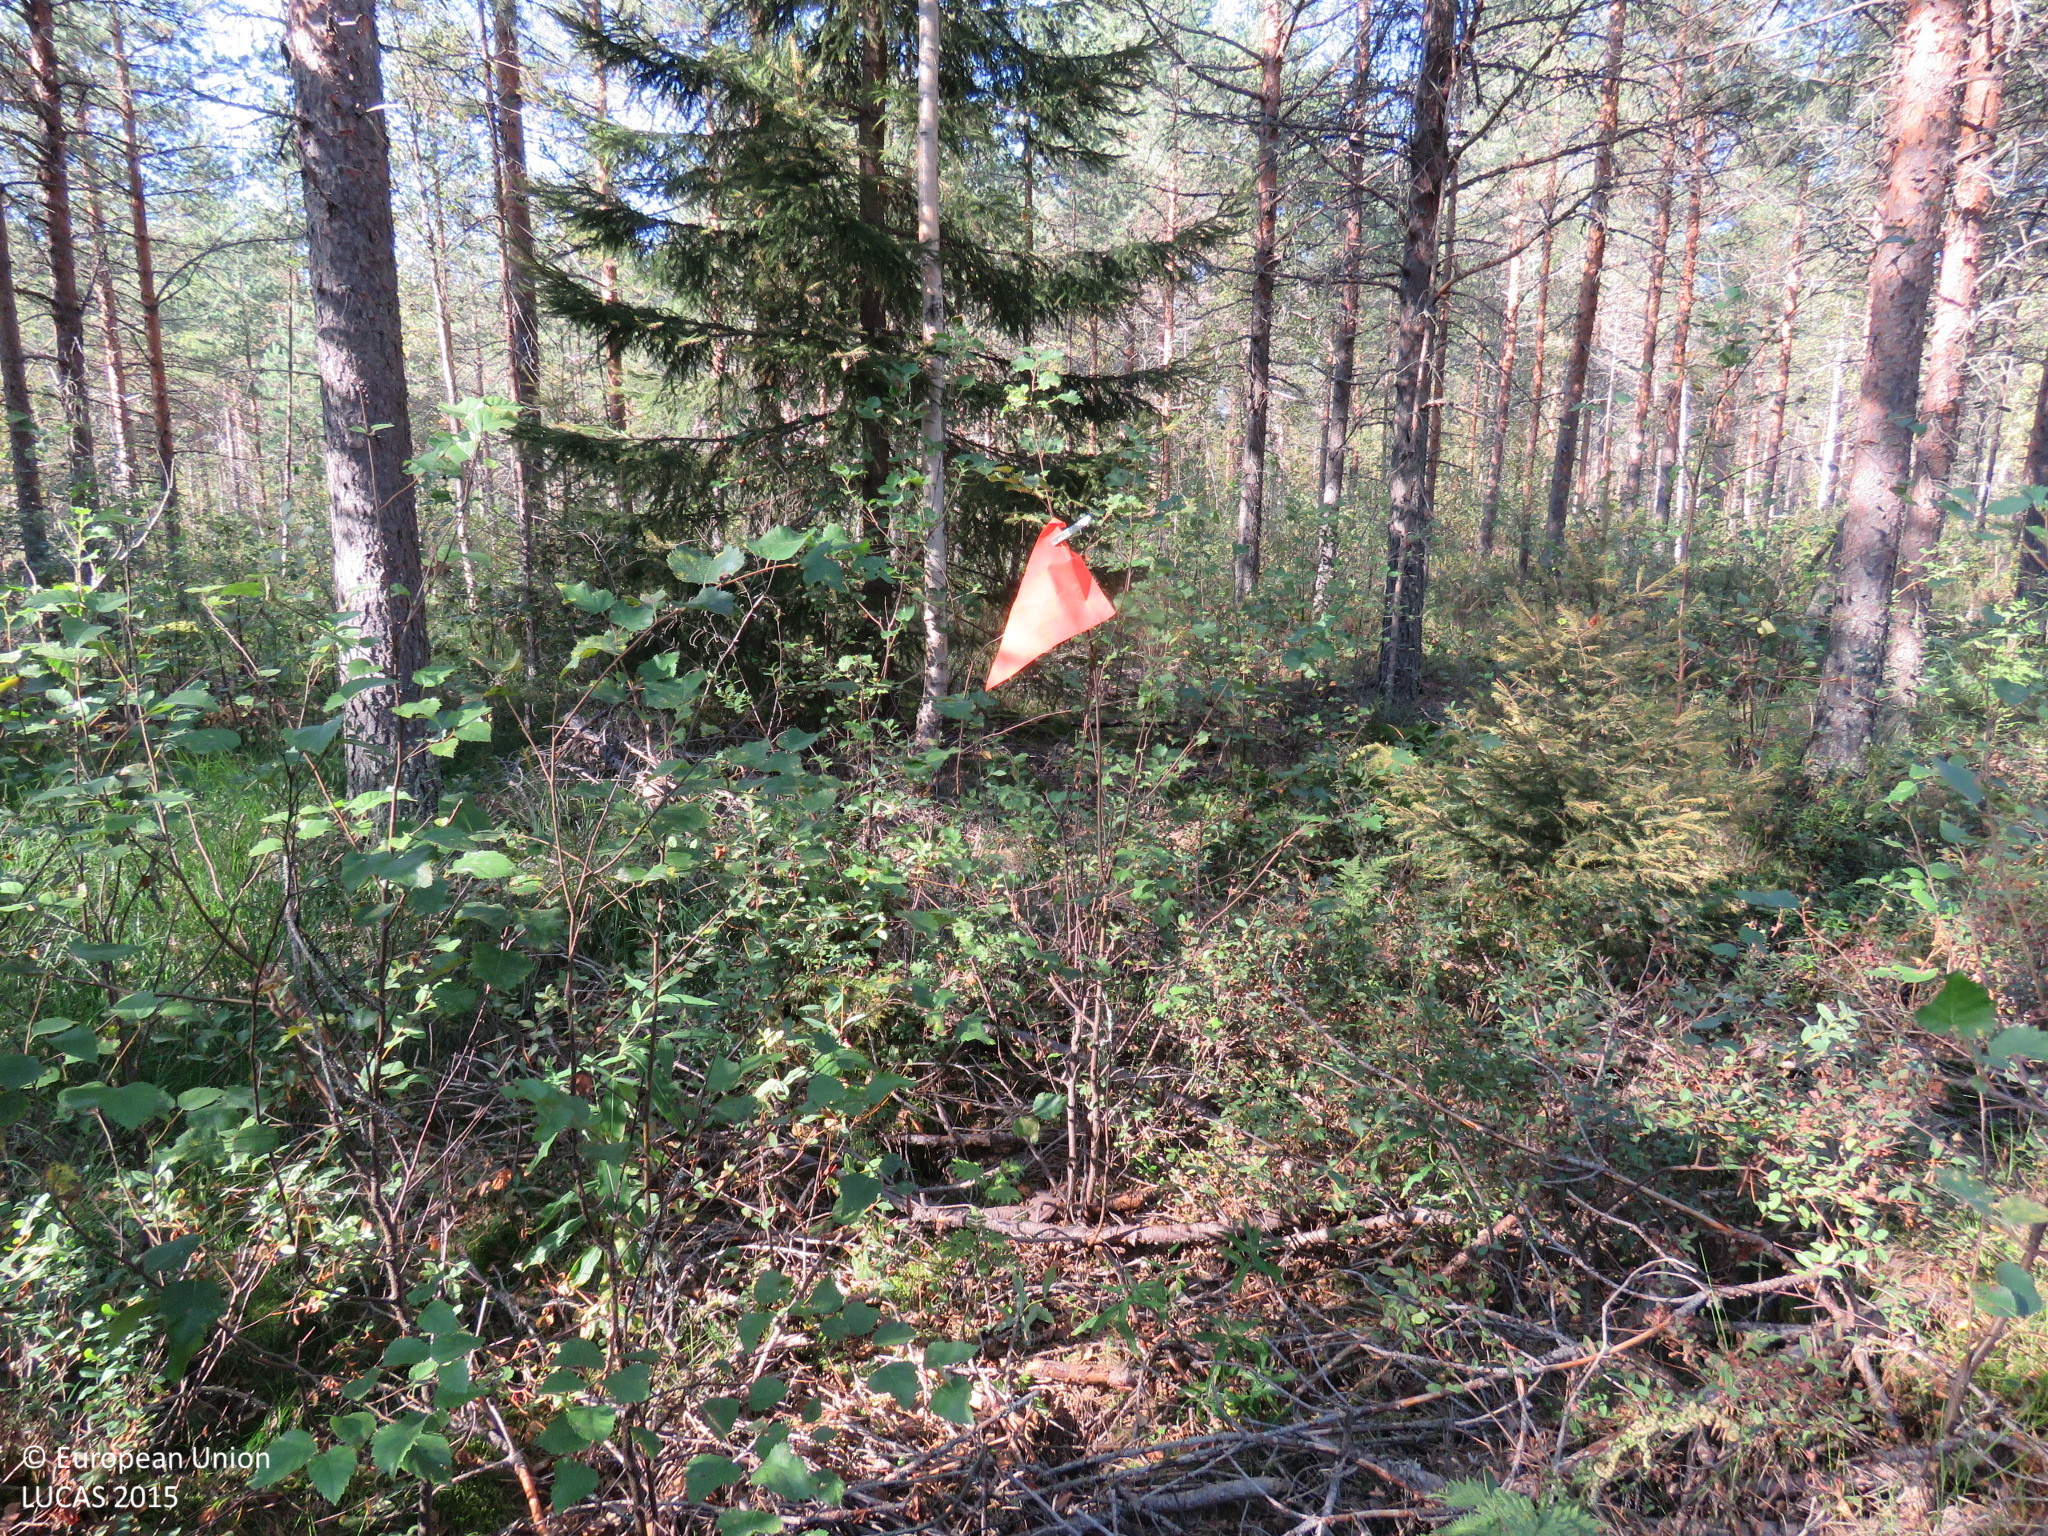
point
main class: Woodland
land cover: Pine dominated mixed woodland
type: mire and swamp forests
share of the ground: > 75 %
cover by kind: coniferous forest trees 60 %, broadleaved forest trees 25 %, shrubs 10 %, herbaceous plants 5 %
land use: Forestry
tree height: > 5 m
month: August
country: FI
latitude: 64.9998
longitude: 25.6745
